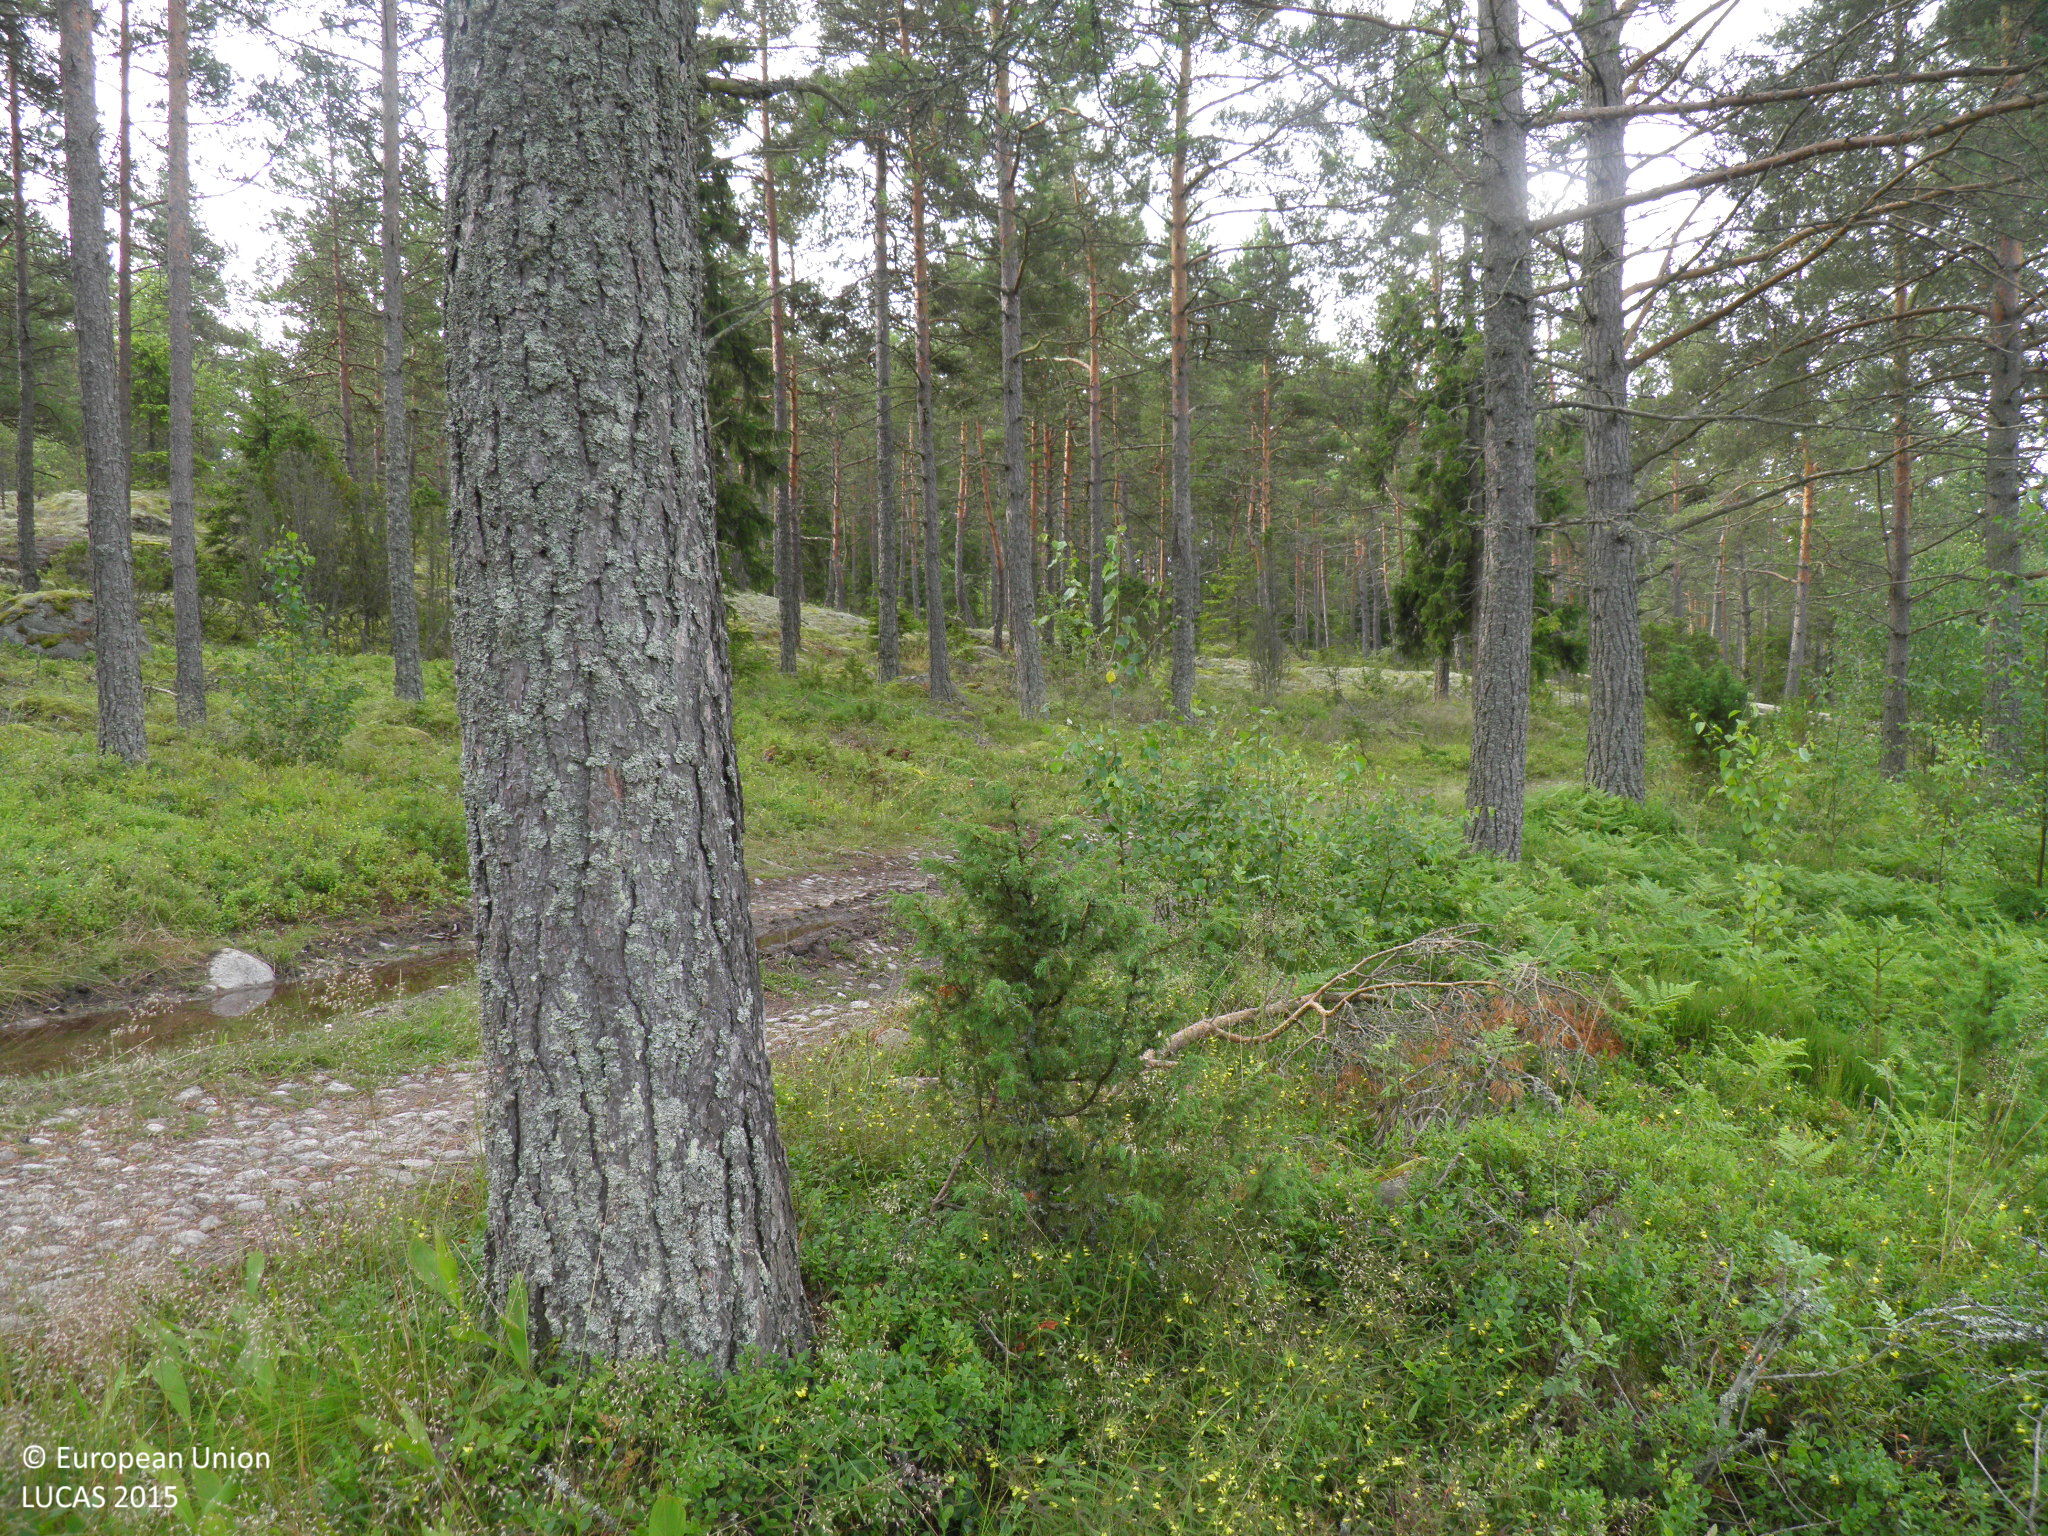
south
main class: Woodland
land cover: Pine dominated coniferous woodland
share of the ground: 50 - 75 %
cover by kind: coniferous forest trees 40 %, shrubs 30 %, broadleaved forest trees 10 %, herbaceous plants 10 %, lichens and mosses 10 %
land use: Forestry
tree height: > 5 m
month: July
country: FI
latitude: 60.6835
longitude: 21.3876
